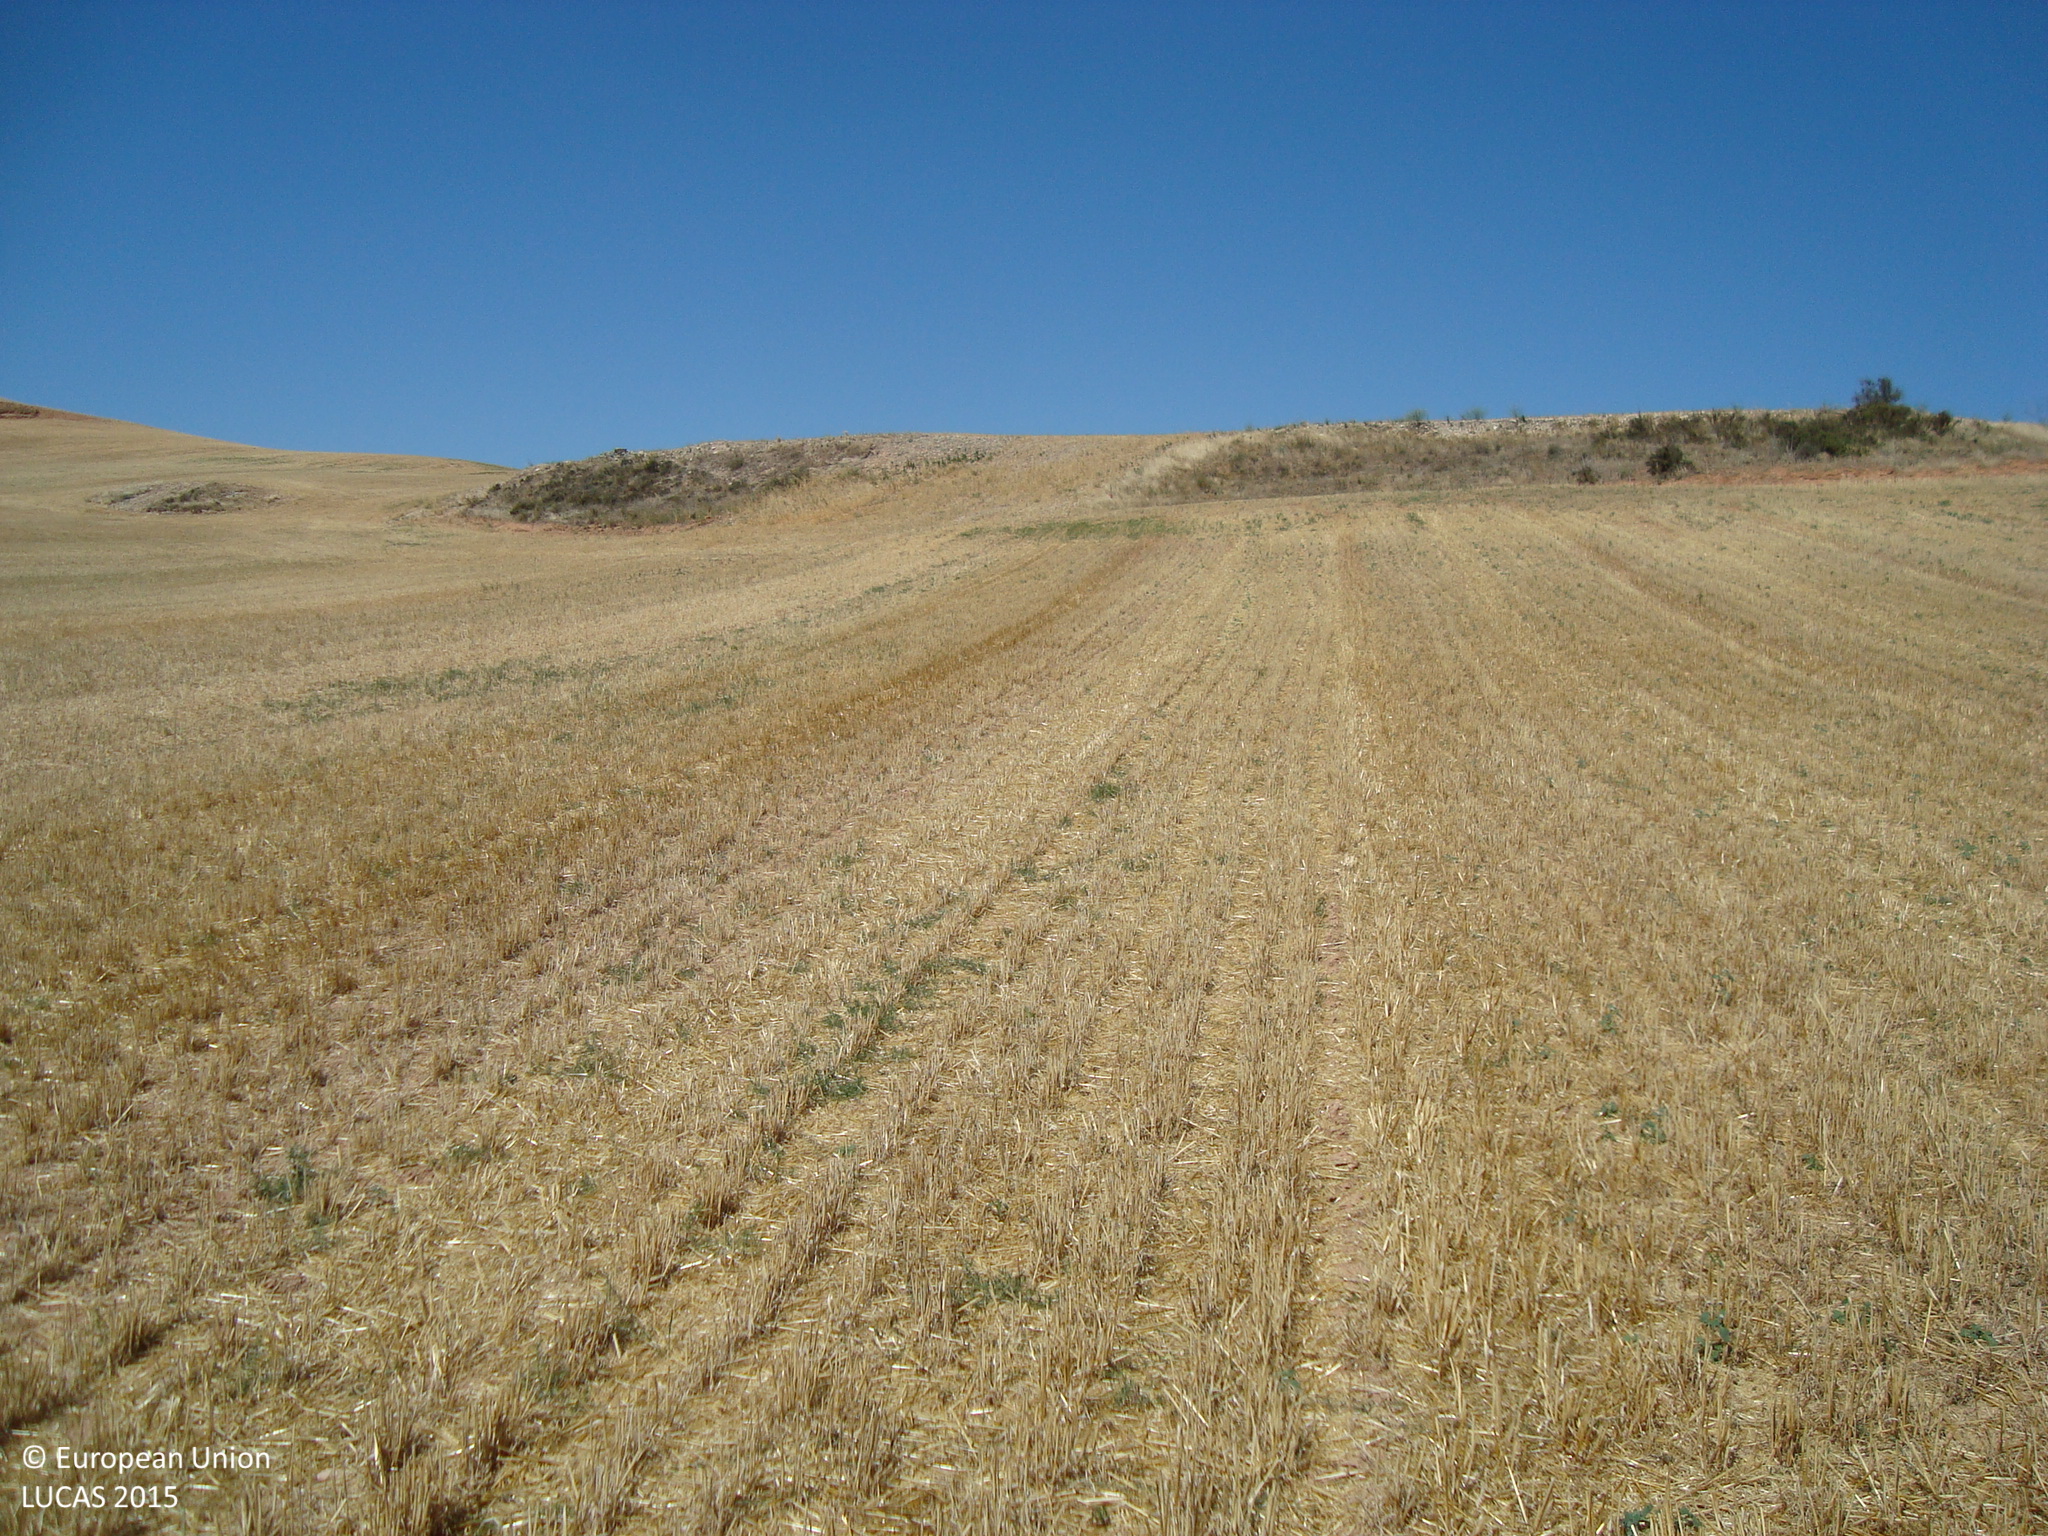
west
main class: Cropland
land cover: Barley
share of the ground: > 75 %
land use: Agriculture (excluding fallow land and kitchen gardens)
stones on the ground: 10 - 25 %
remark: Harvested field
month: July
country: ES
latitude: 42.0214
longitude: -3.8878
